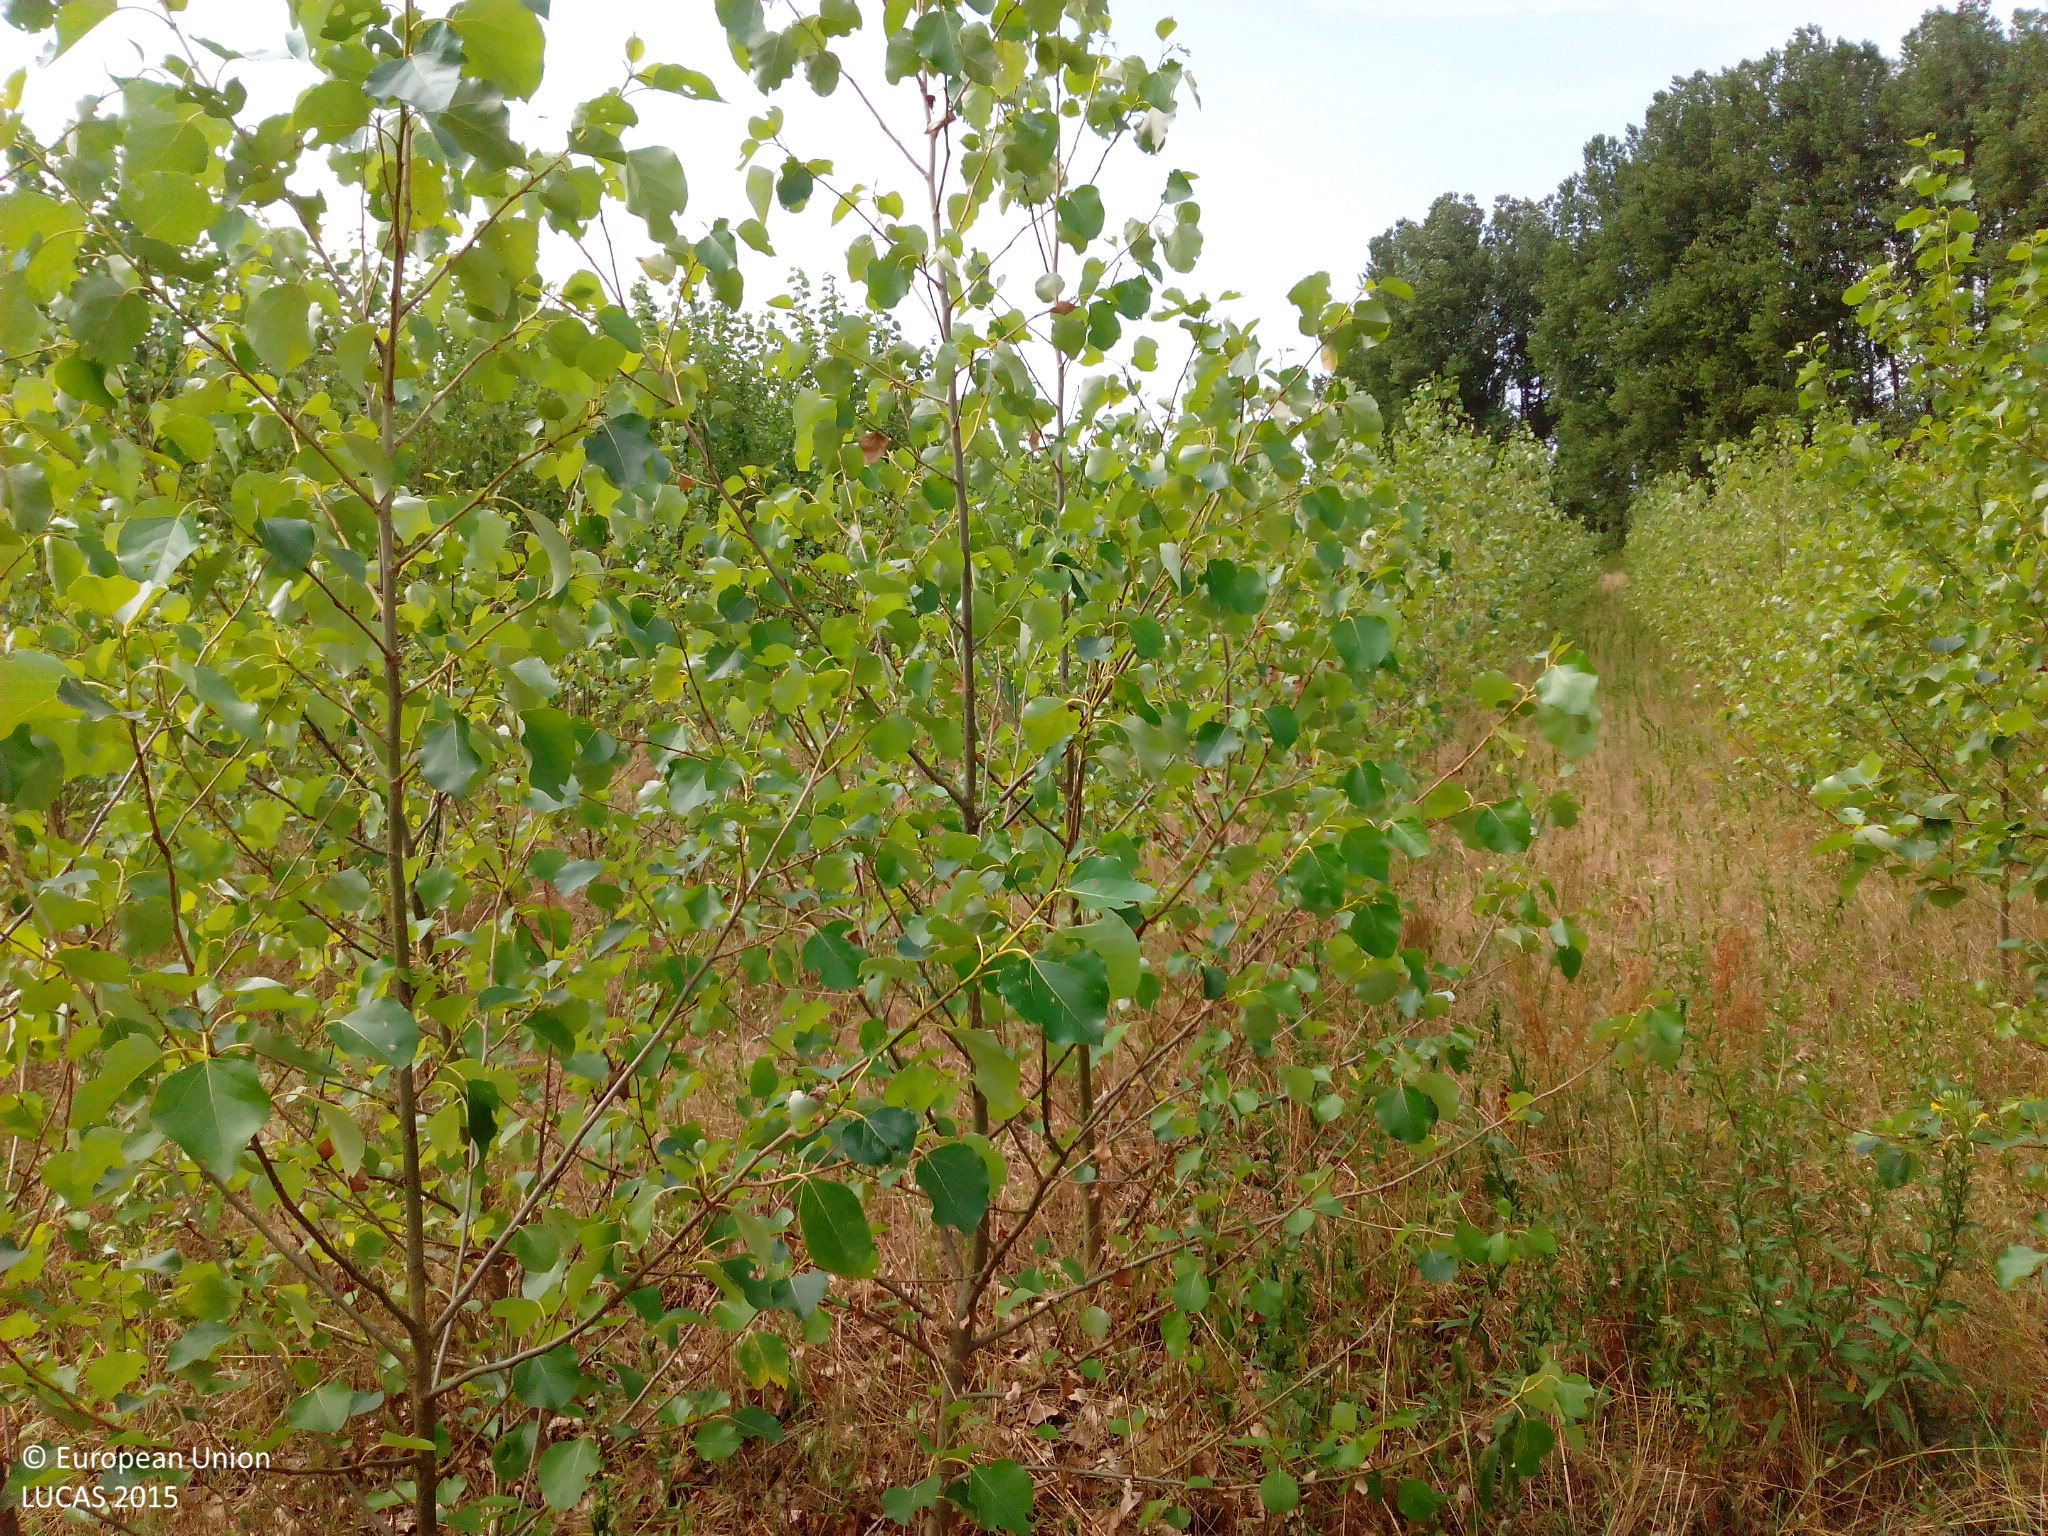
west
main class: Woodland
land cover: Broadleaved woodland
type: mesophytic deciduous forest
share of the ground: 25 - 50 %
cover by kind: broadleaved forest trees 50 %, herbaceous plants 50 %
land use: Semi-natural and natural areas not in use
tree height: < 5 m
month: August
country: DE
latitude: 52.6767
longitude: 13.1798
